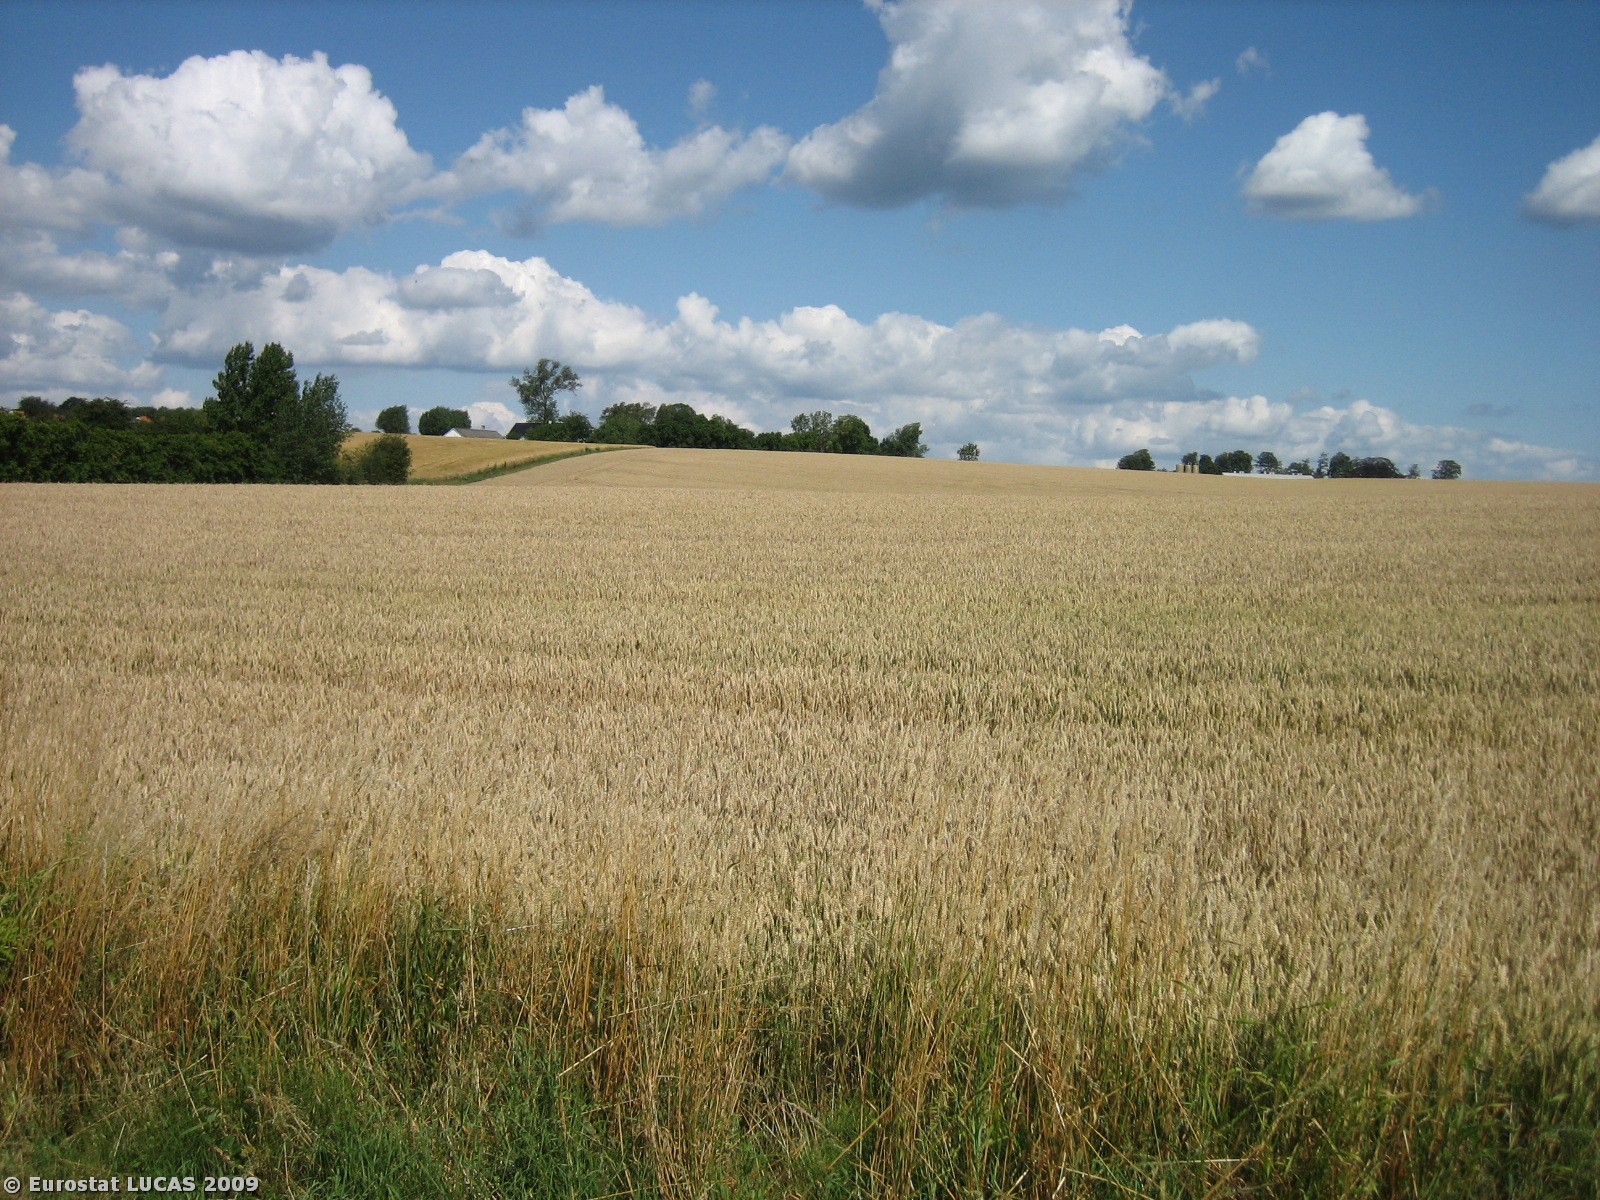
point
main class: Cropland
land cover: Common wheat
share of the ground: > 75 %
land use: Agriculture (excluding fallow land and kitchen gardens)
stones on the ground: 10 - 25 %
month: July
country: DK
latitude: 55.4867
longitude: 9.9209
